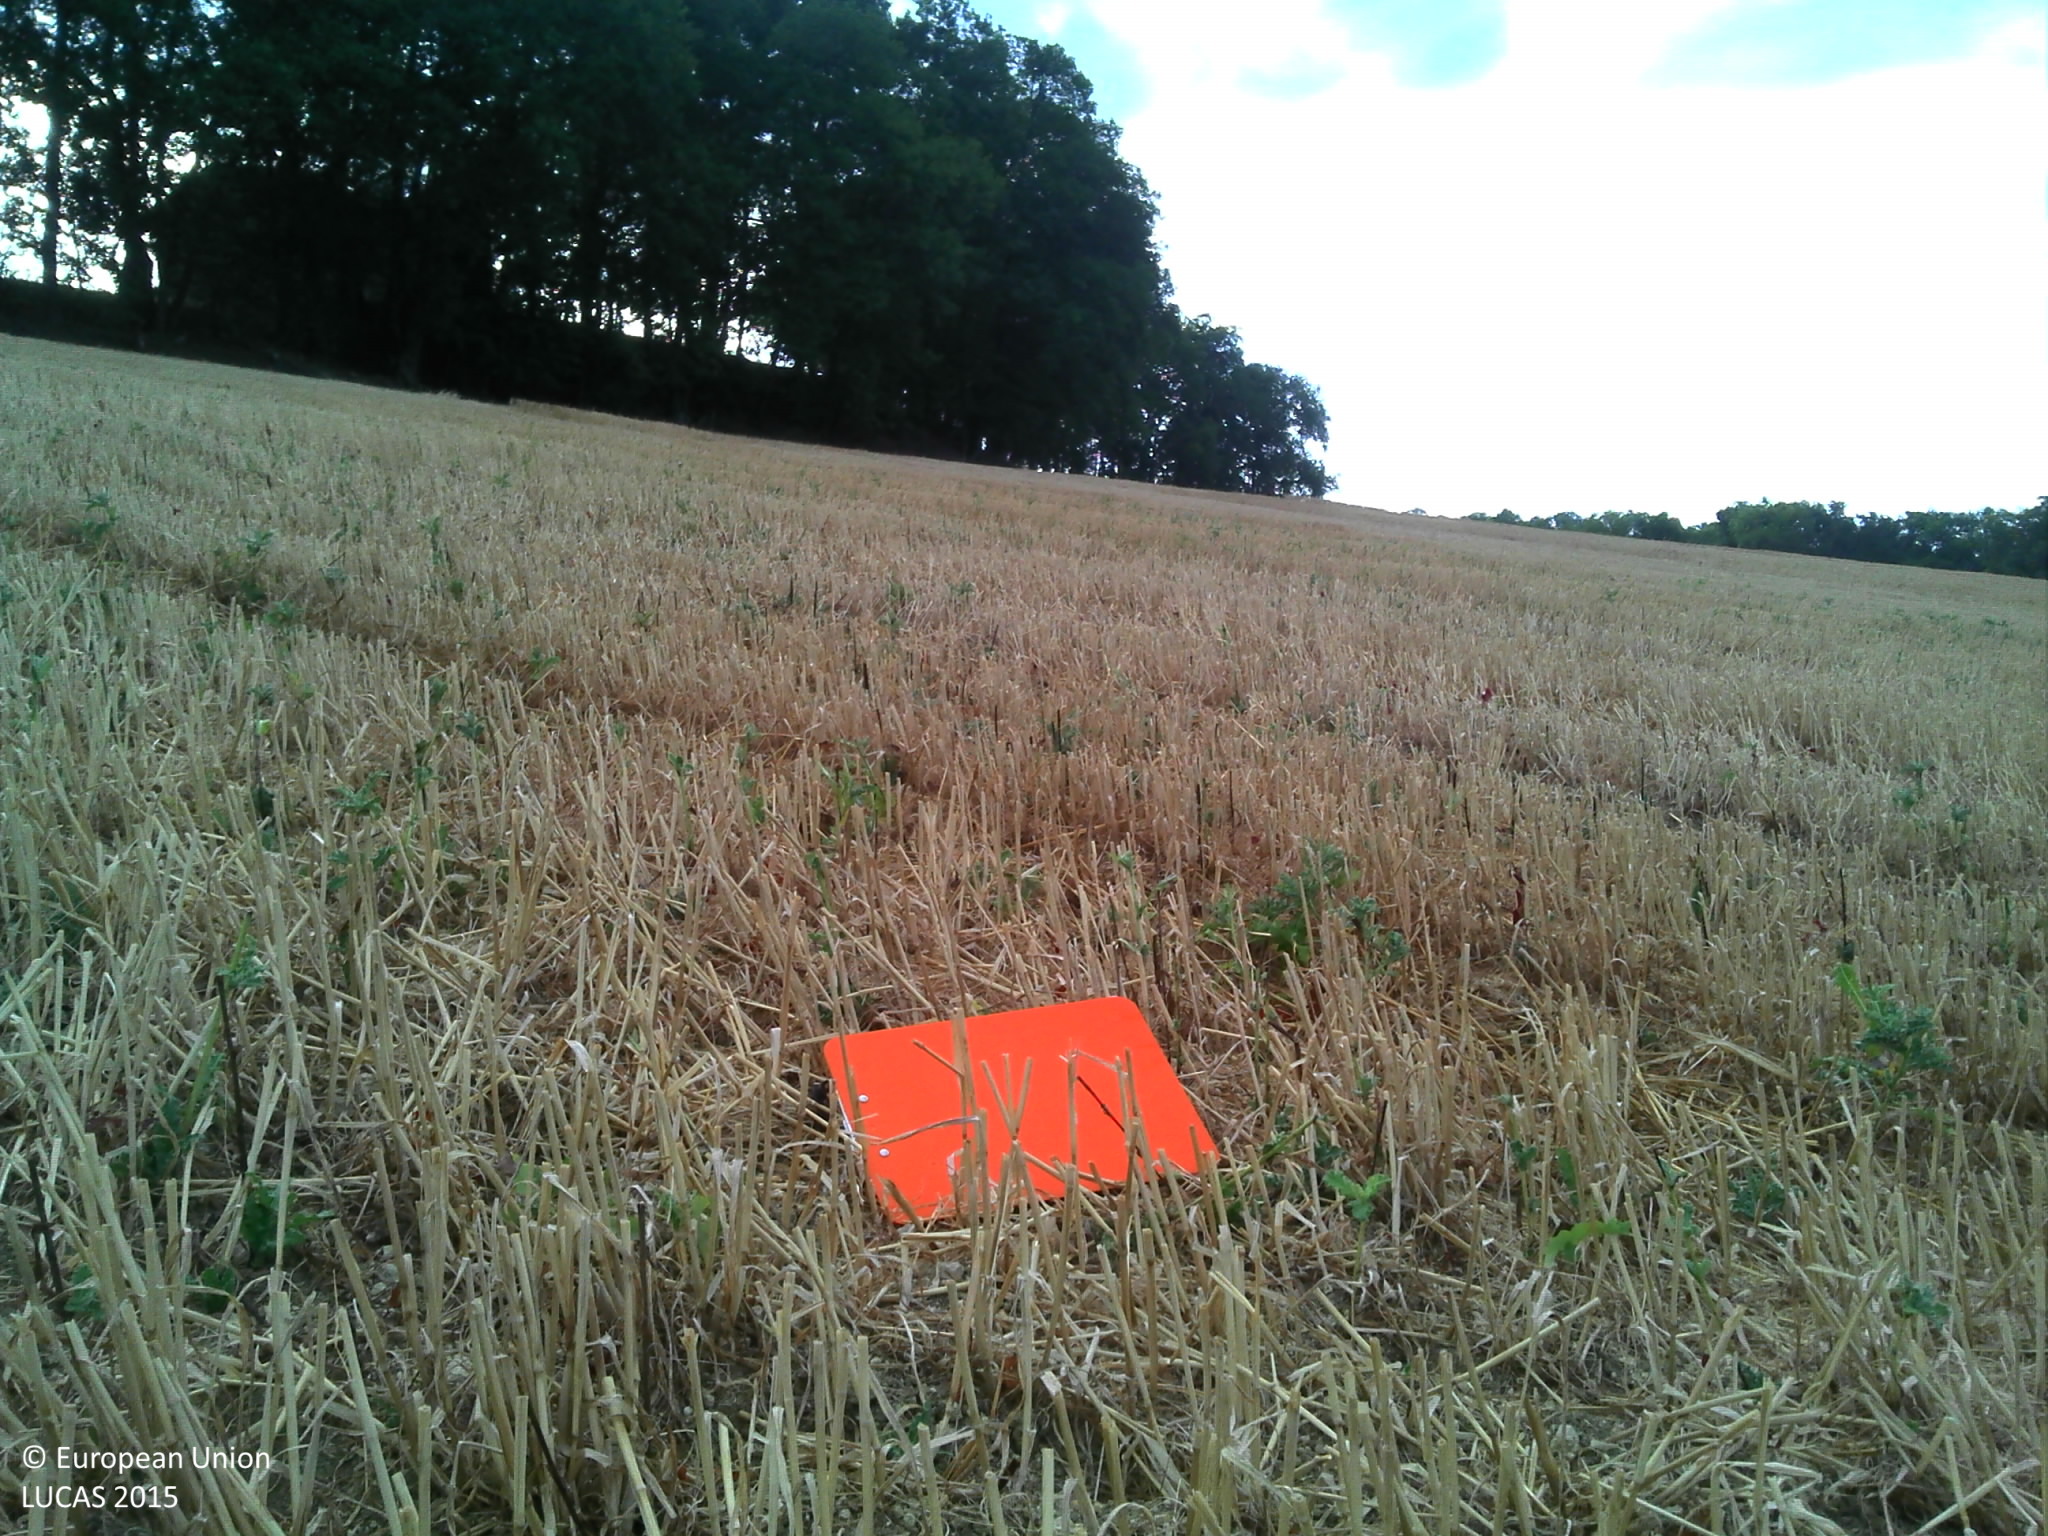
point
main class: Cropland
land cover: Common wheat
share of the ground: > 75 %
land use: Agriculture (excluding fallow land and kitchen gardens)
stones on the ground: < 10 %
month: July
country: FR
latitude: 44.3225
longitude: 0.6022
